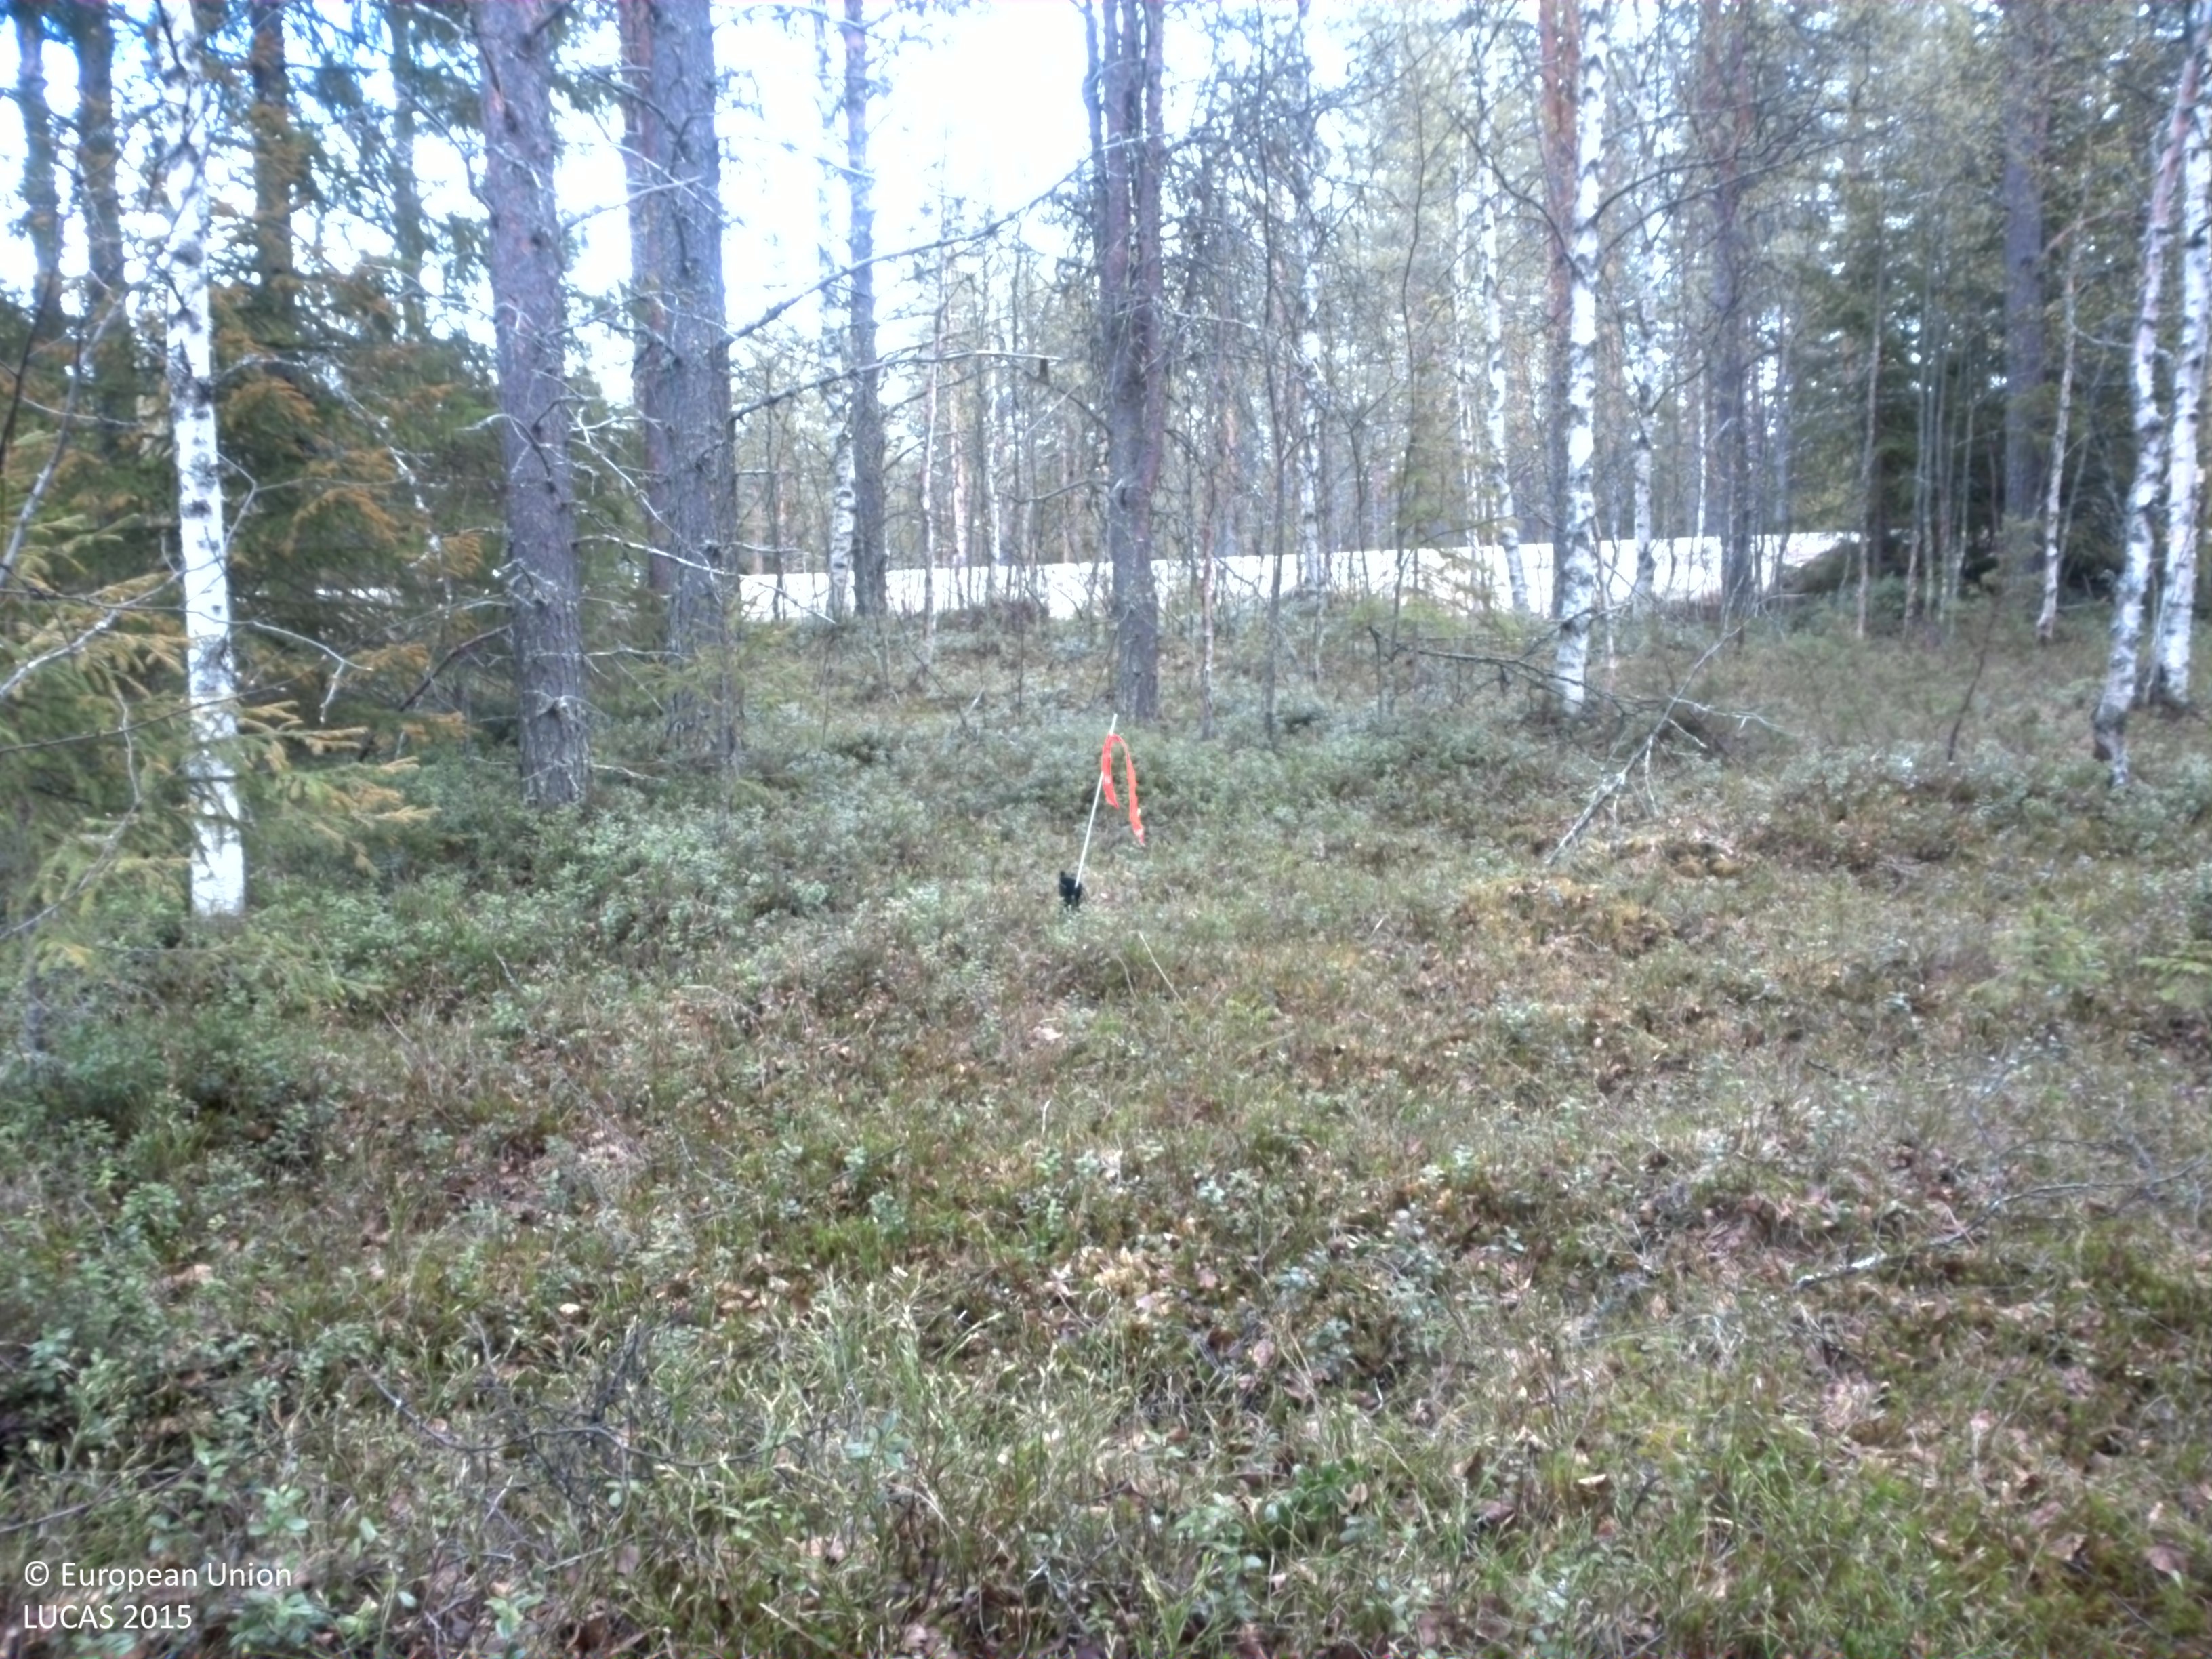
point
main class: Woodland
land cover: Spruce dominated mixed woodland
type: boreal forest
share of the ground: 25 - 50 %
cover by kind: coniferous forest trees 30 %, herbaceous plants 20 %, broadleaved forest trees 15 %, lichens and mosses 10 %, shrubs 5 %, consolidated bare surface 5 %, unconsolidated bare surface 5 %
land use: Forestry
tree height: > 5 m
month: June
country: SE
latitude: 64.3343
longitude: 18.1428
